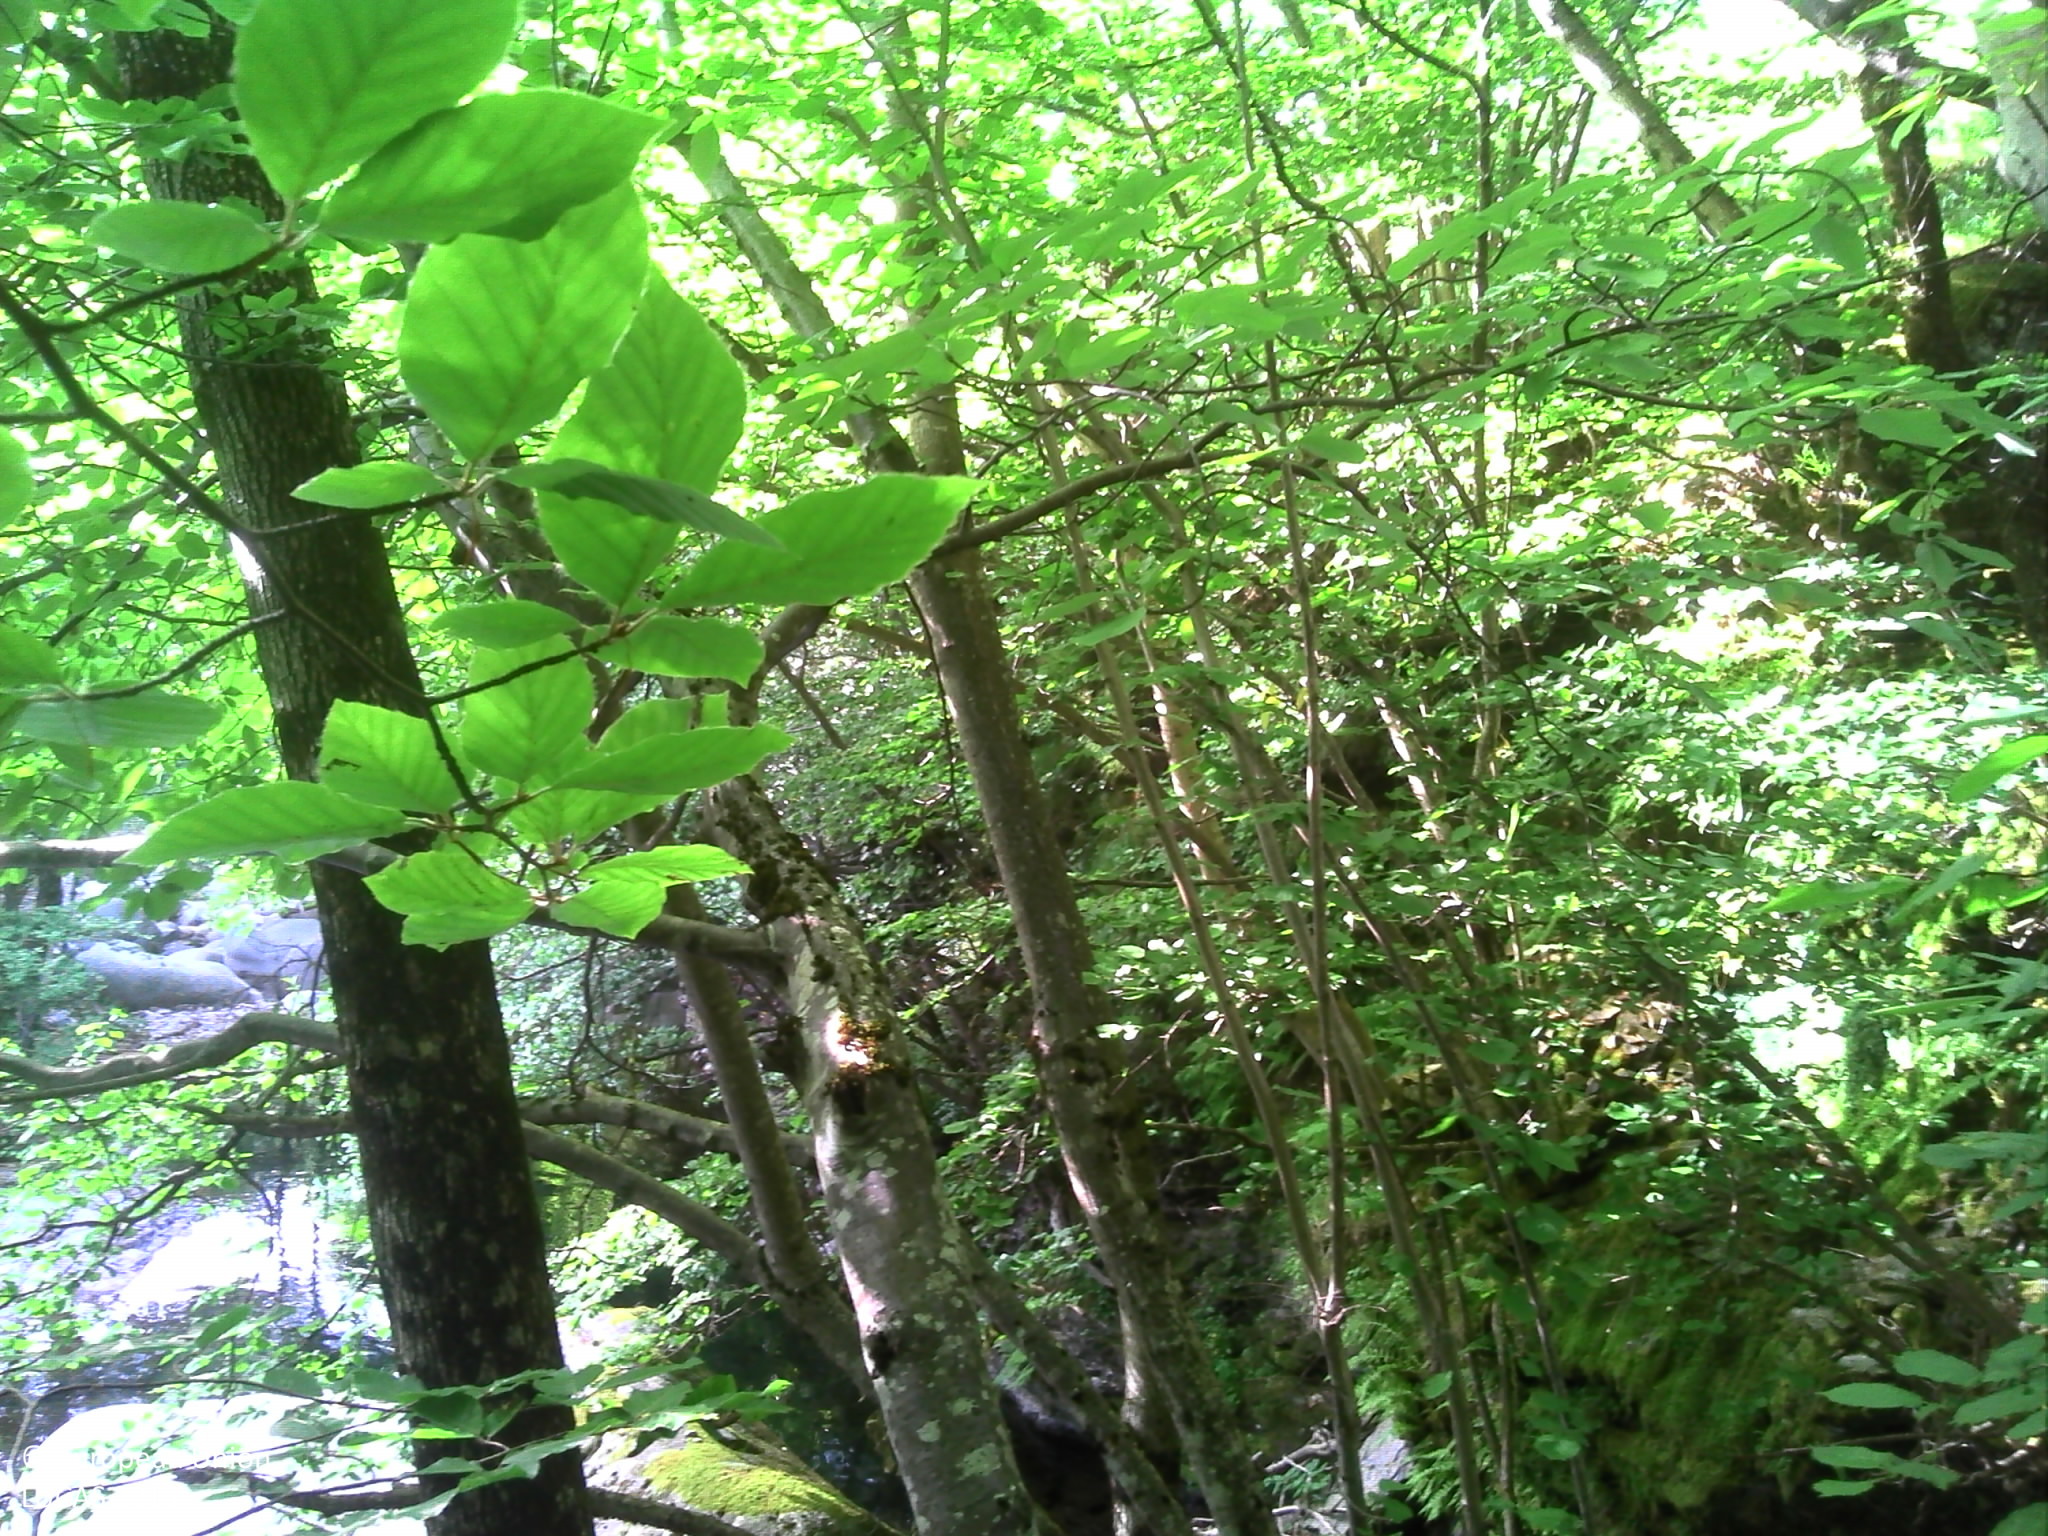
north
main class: Woodland
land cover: Broadleaved woodland
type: beech forest
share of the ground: > 75 %
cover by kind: broadleaved forest trees 85 %, herbaceous plants 10 %, coniferous forest trees 5 %
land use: Forestry
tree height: > 5 m
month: June
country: FR
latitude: 44.4251
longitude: 3.9142
